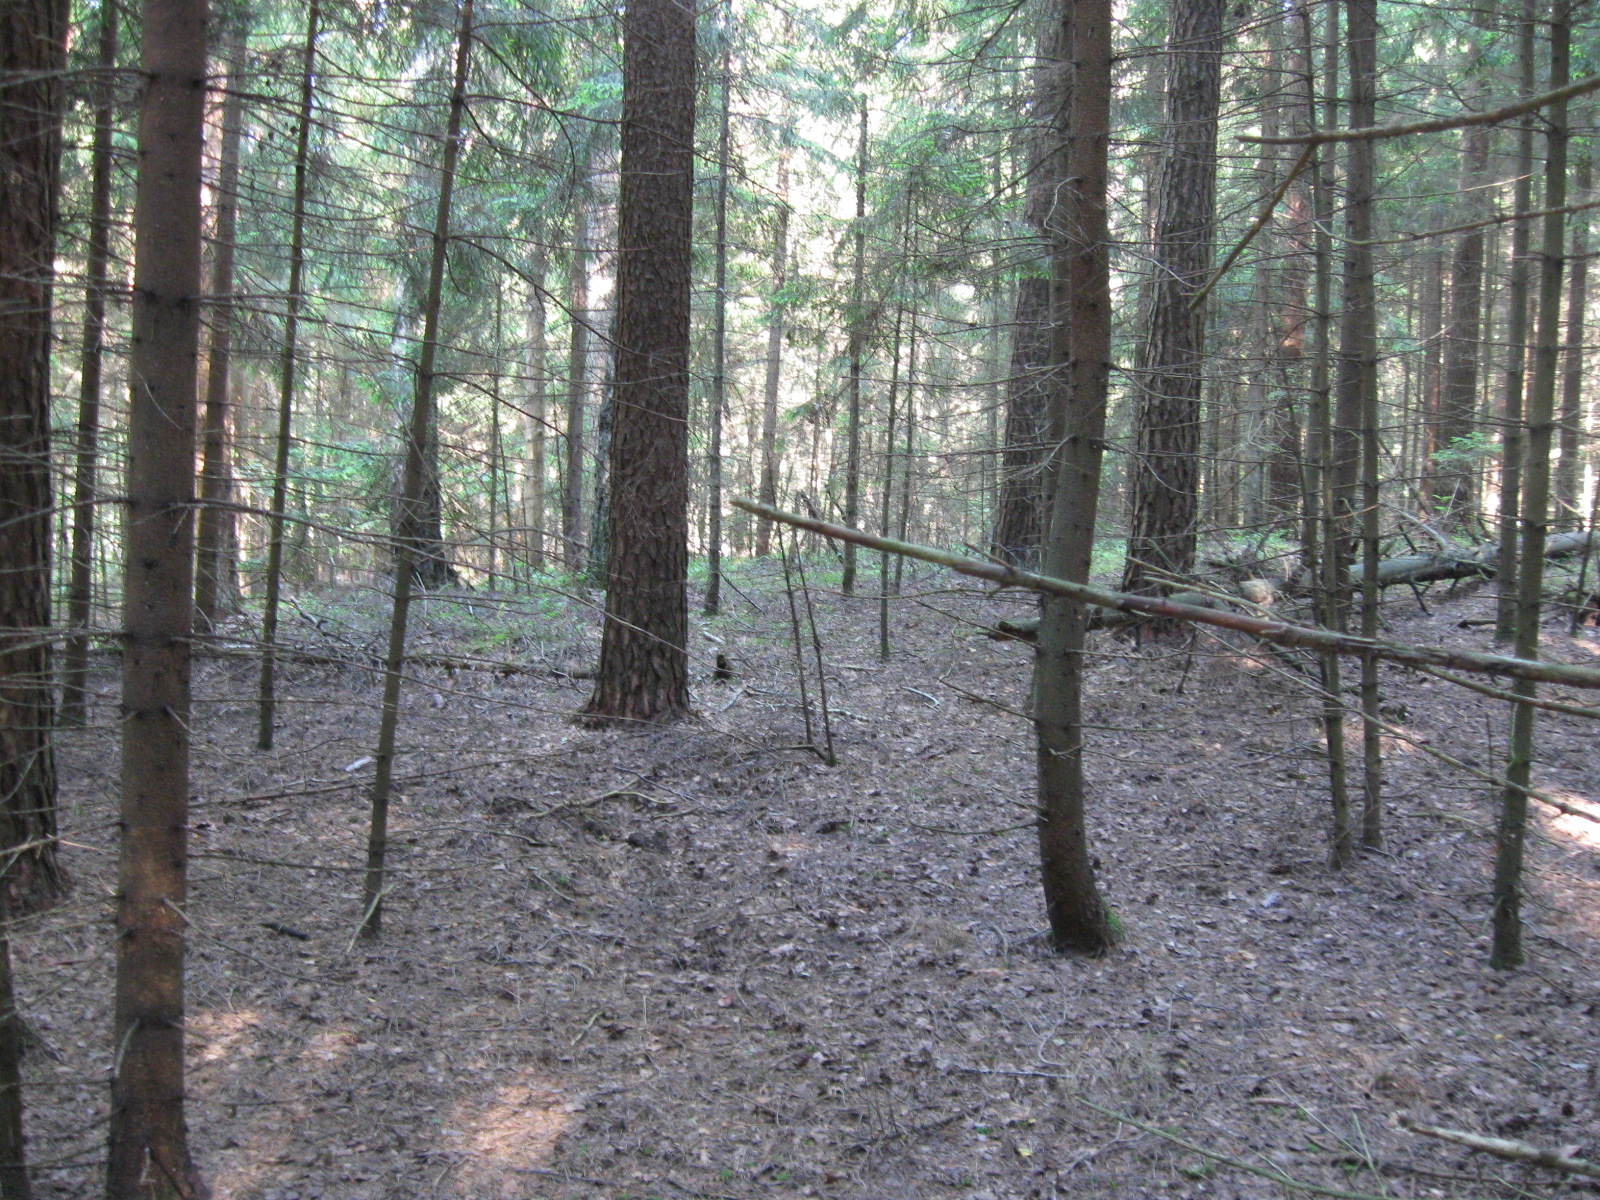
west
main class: Woodland
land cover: Spruce dominated coniferous woodland
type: hemiboreal forest and nemoral coniferous forest and mixed broadleaved-coniferous forest
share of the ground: > 75 %
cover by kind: coniferous forest trees 95 %, broadleaved forest trees 5 %
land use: Forestry
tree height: > 5 m
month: June
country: LT
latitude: 54.0711
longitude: 24.7026
